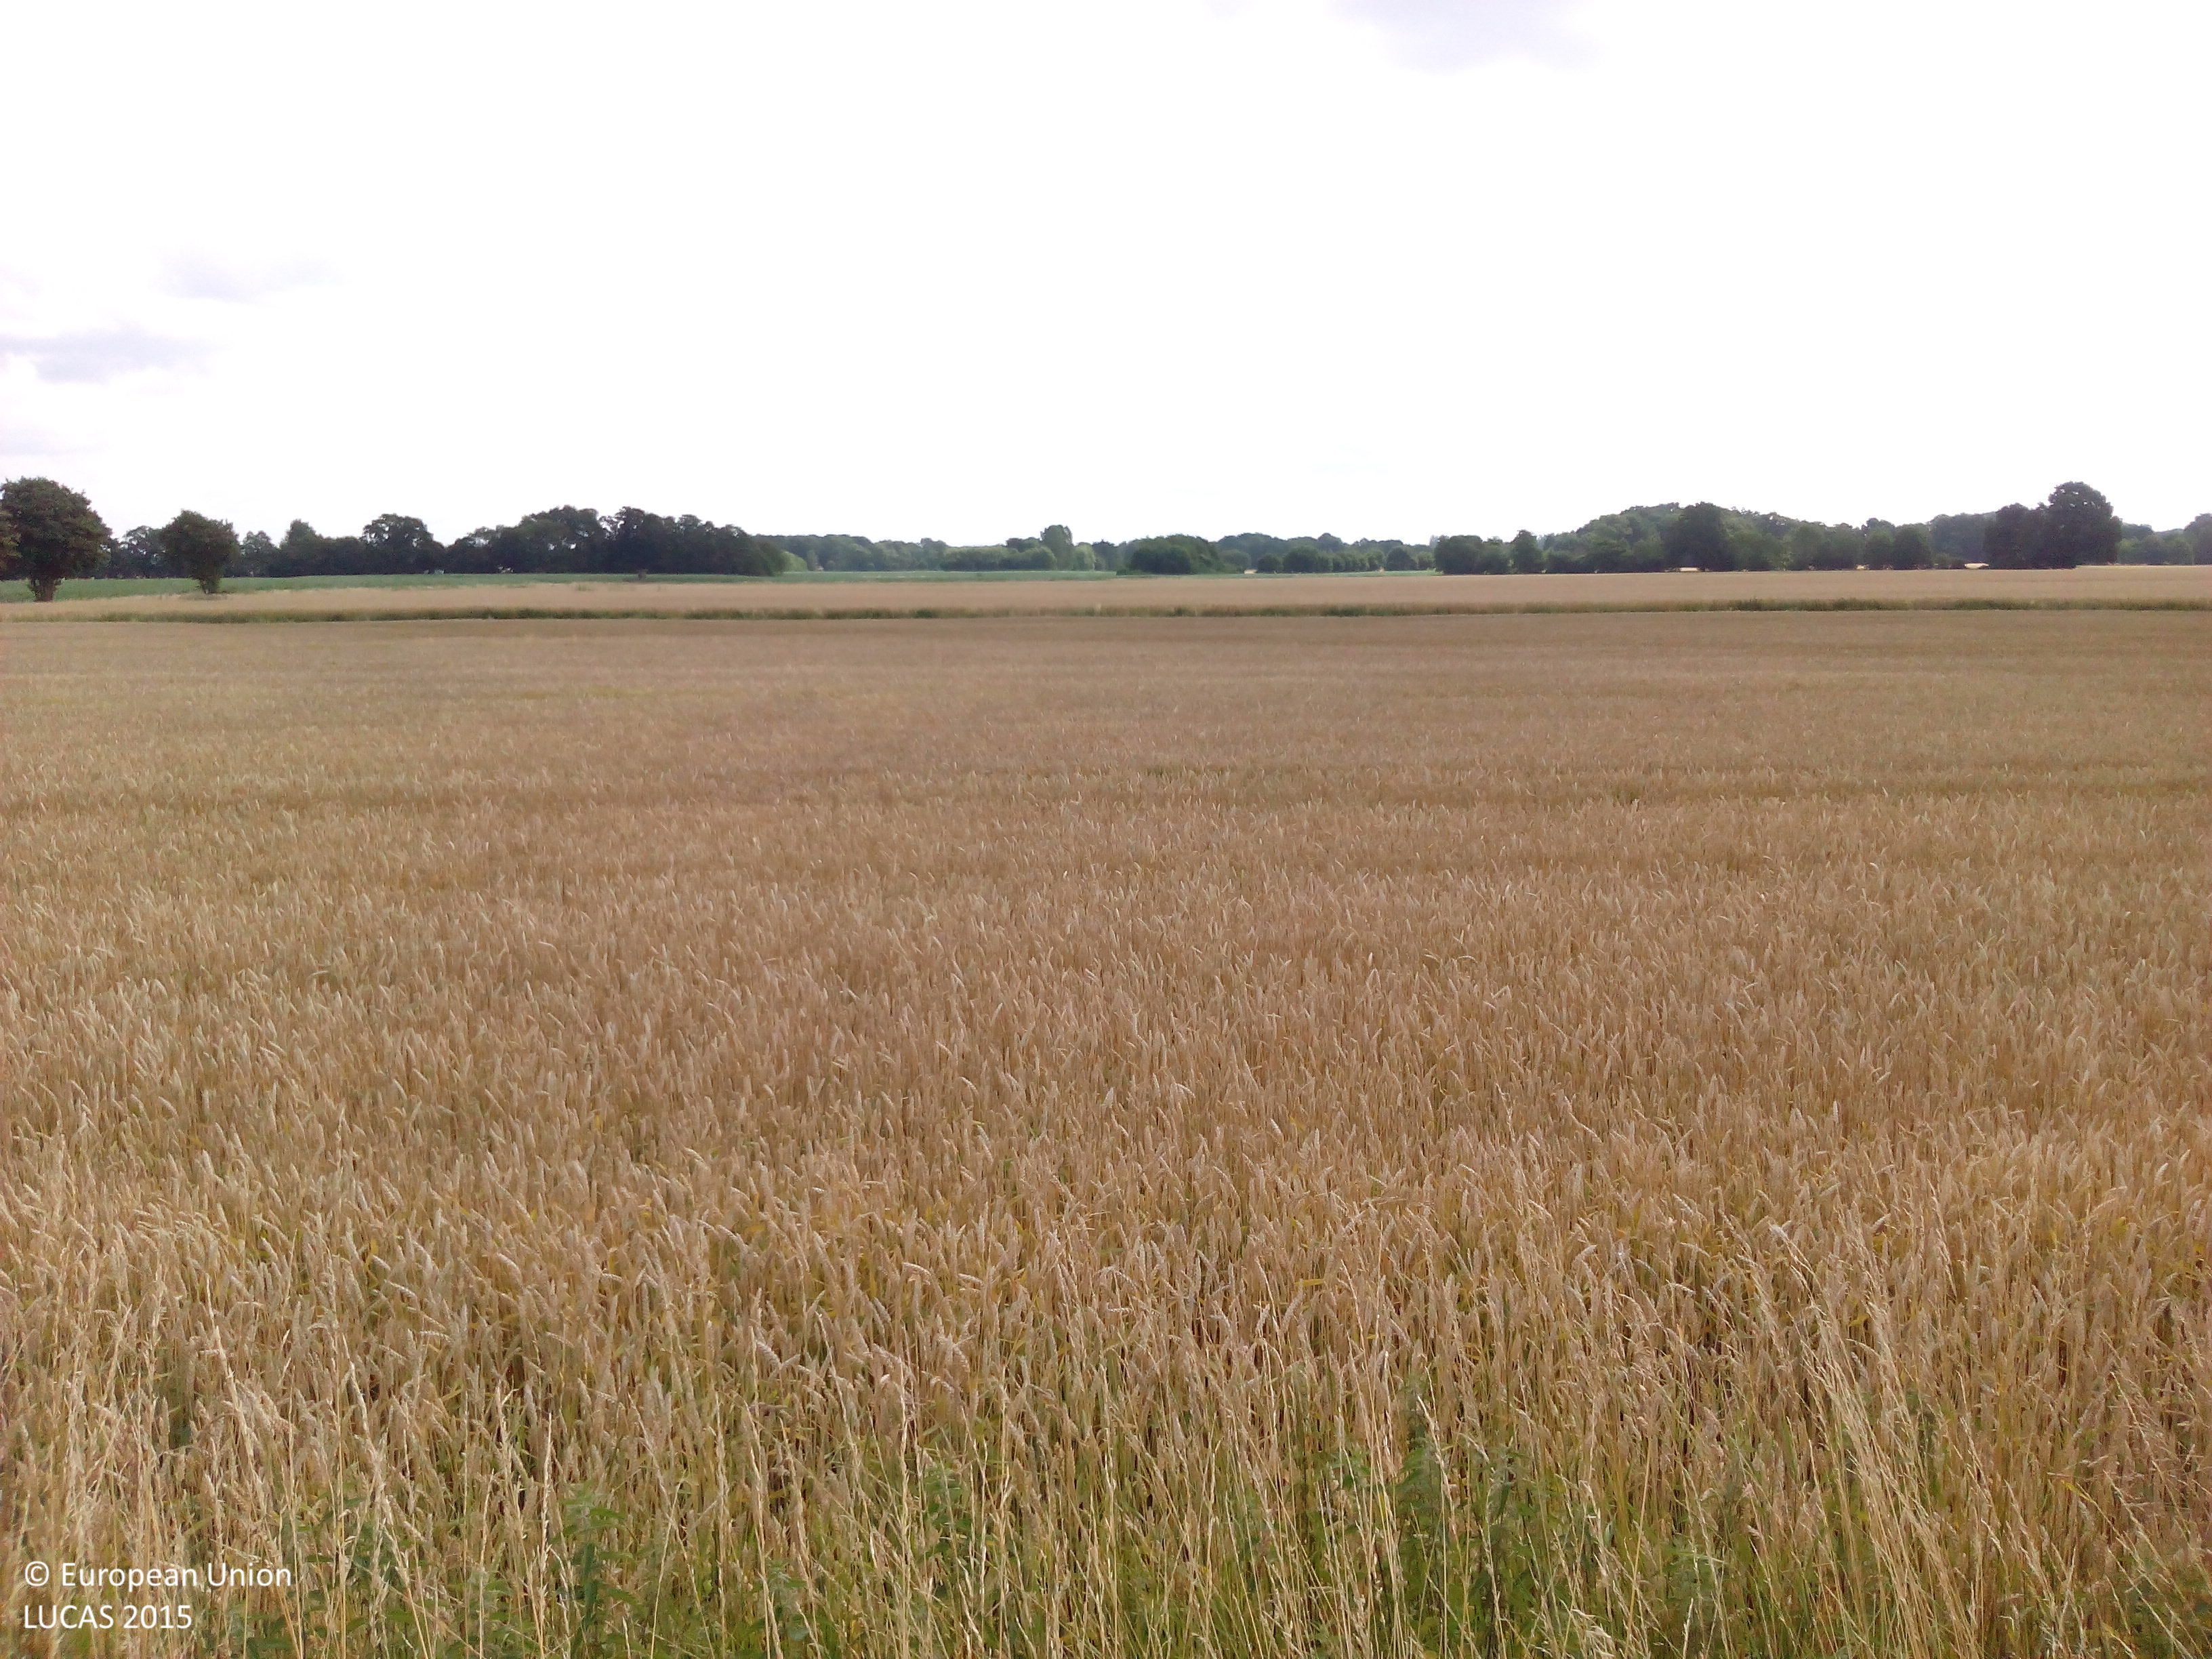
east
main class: Cropland
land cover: Common wheat
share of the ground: > 75 %
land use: Agriculture (excluding fallow land and kitchen gardens)
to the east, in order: Common wheat; Inland fresh running water; Common wheat
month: July
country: DE
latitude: 52.6304
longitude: 8.0059
